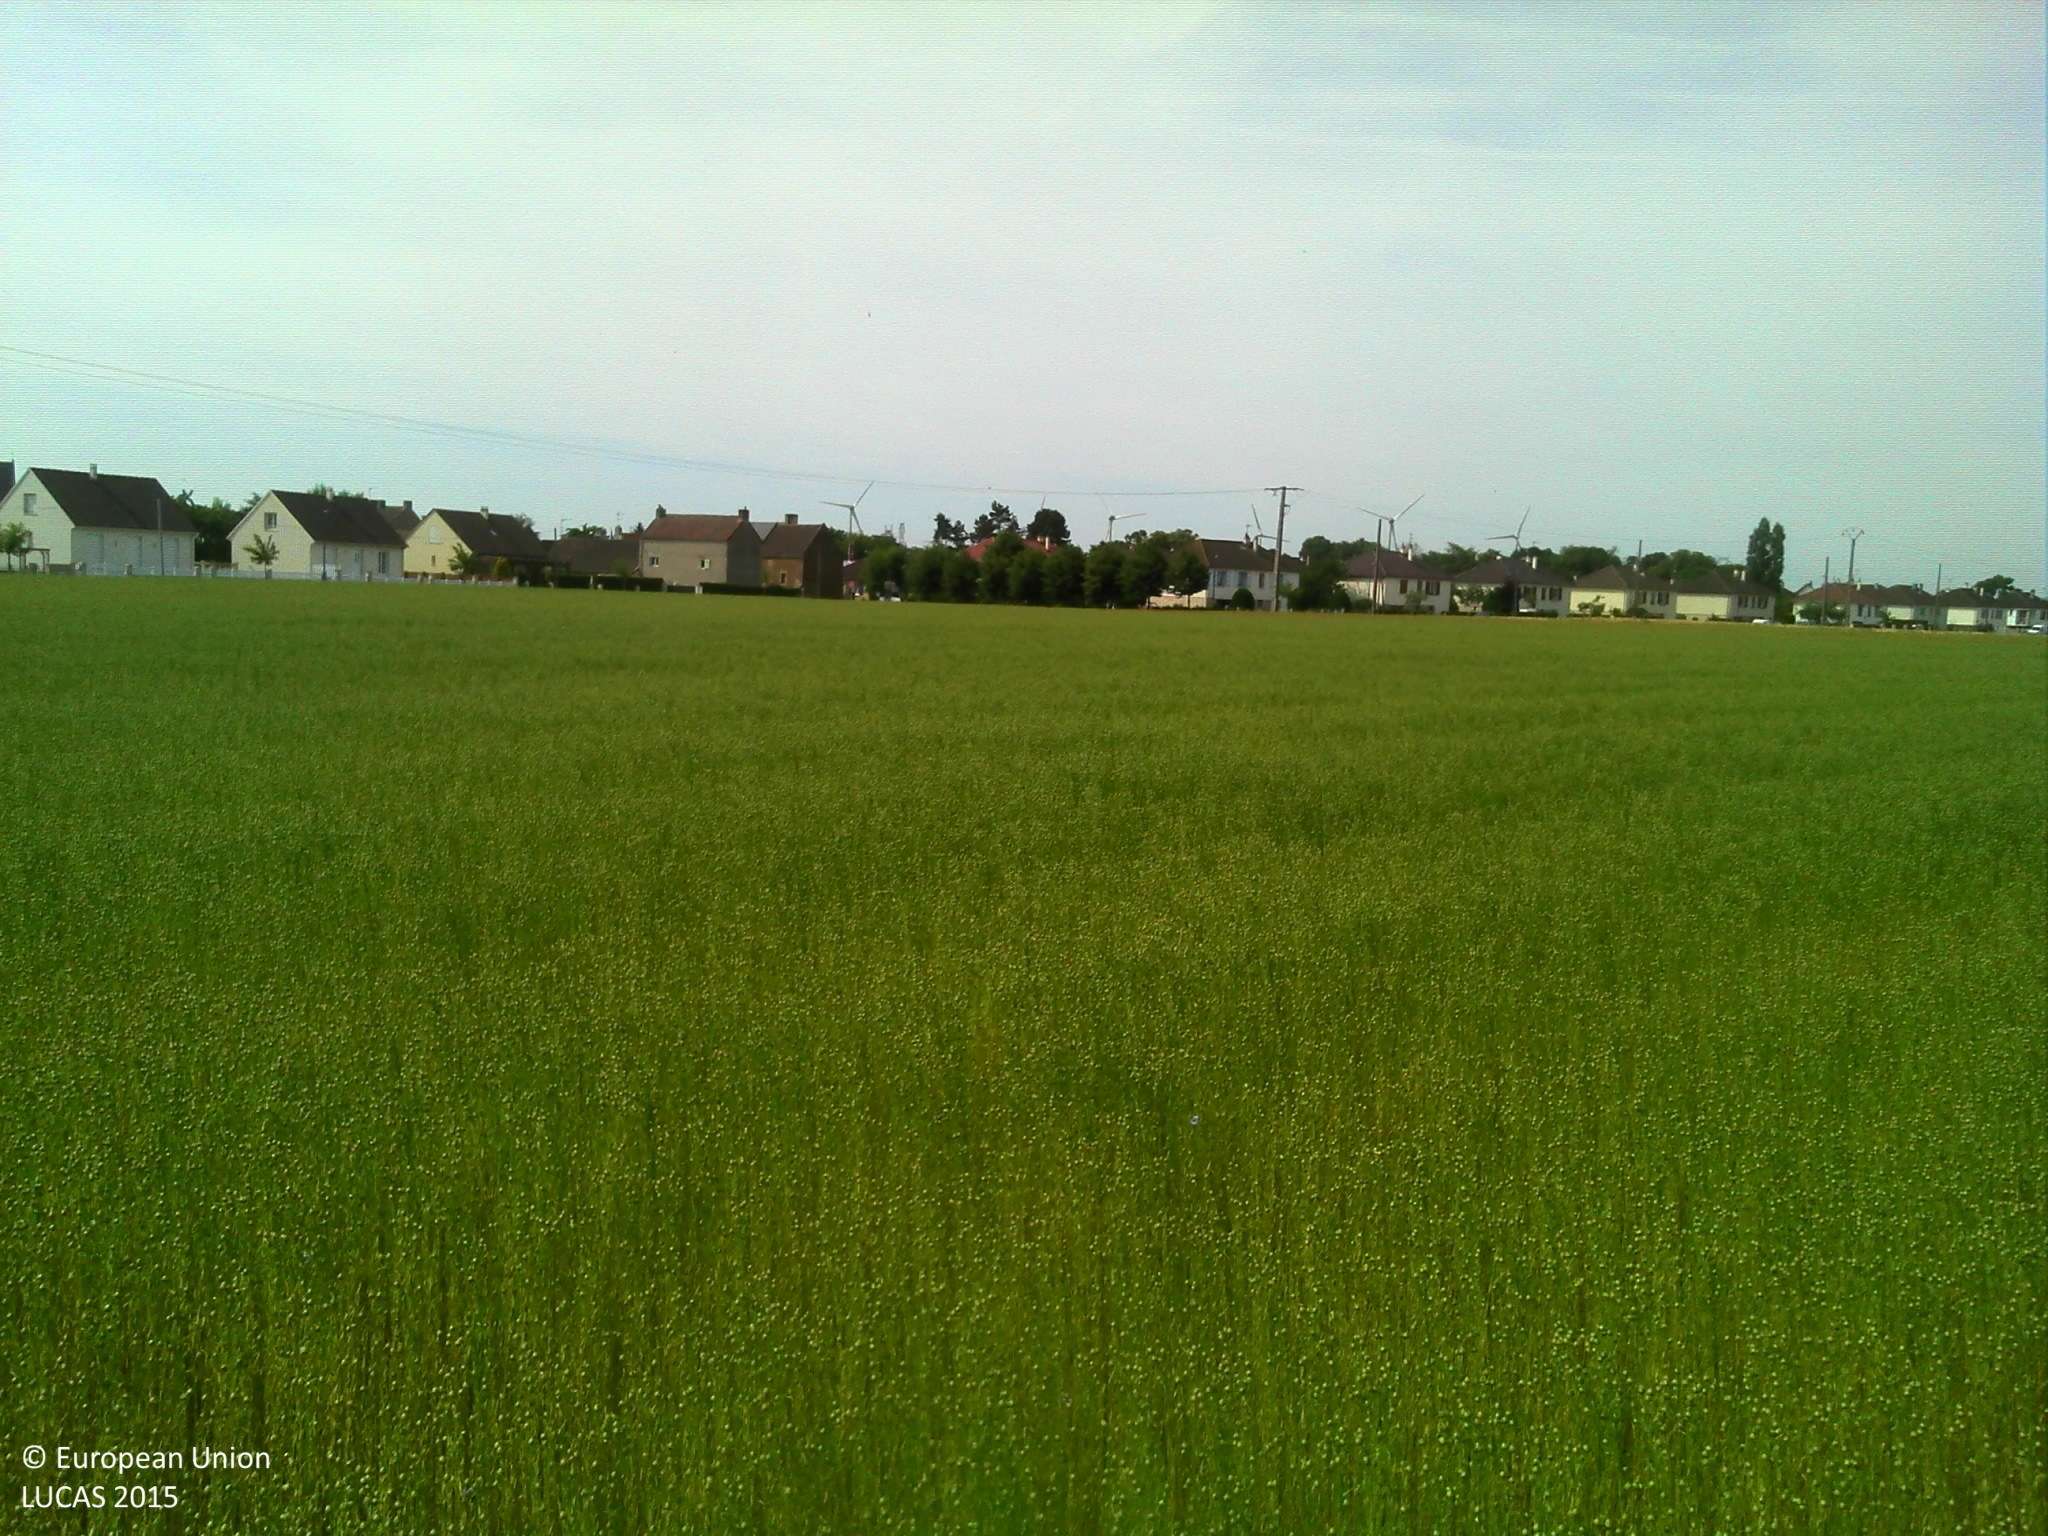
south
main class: Cropland
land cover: Other fibre and oleaginous crops
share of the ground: > 75 %
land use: Agriculture (excluding fallow land and kitchen gardens)
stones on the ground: < 10 %
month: June
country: FR
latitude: 49.1413
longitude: -0.2458
